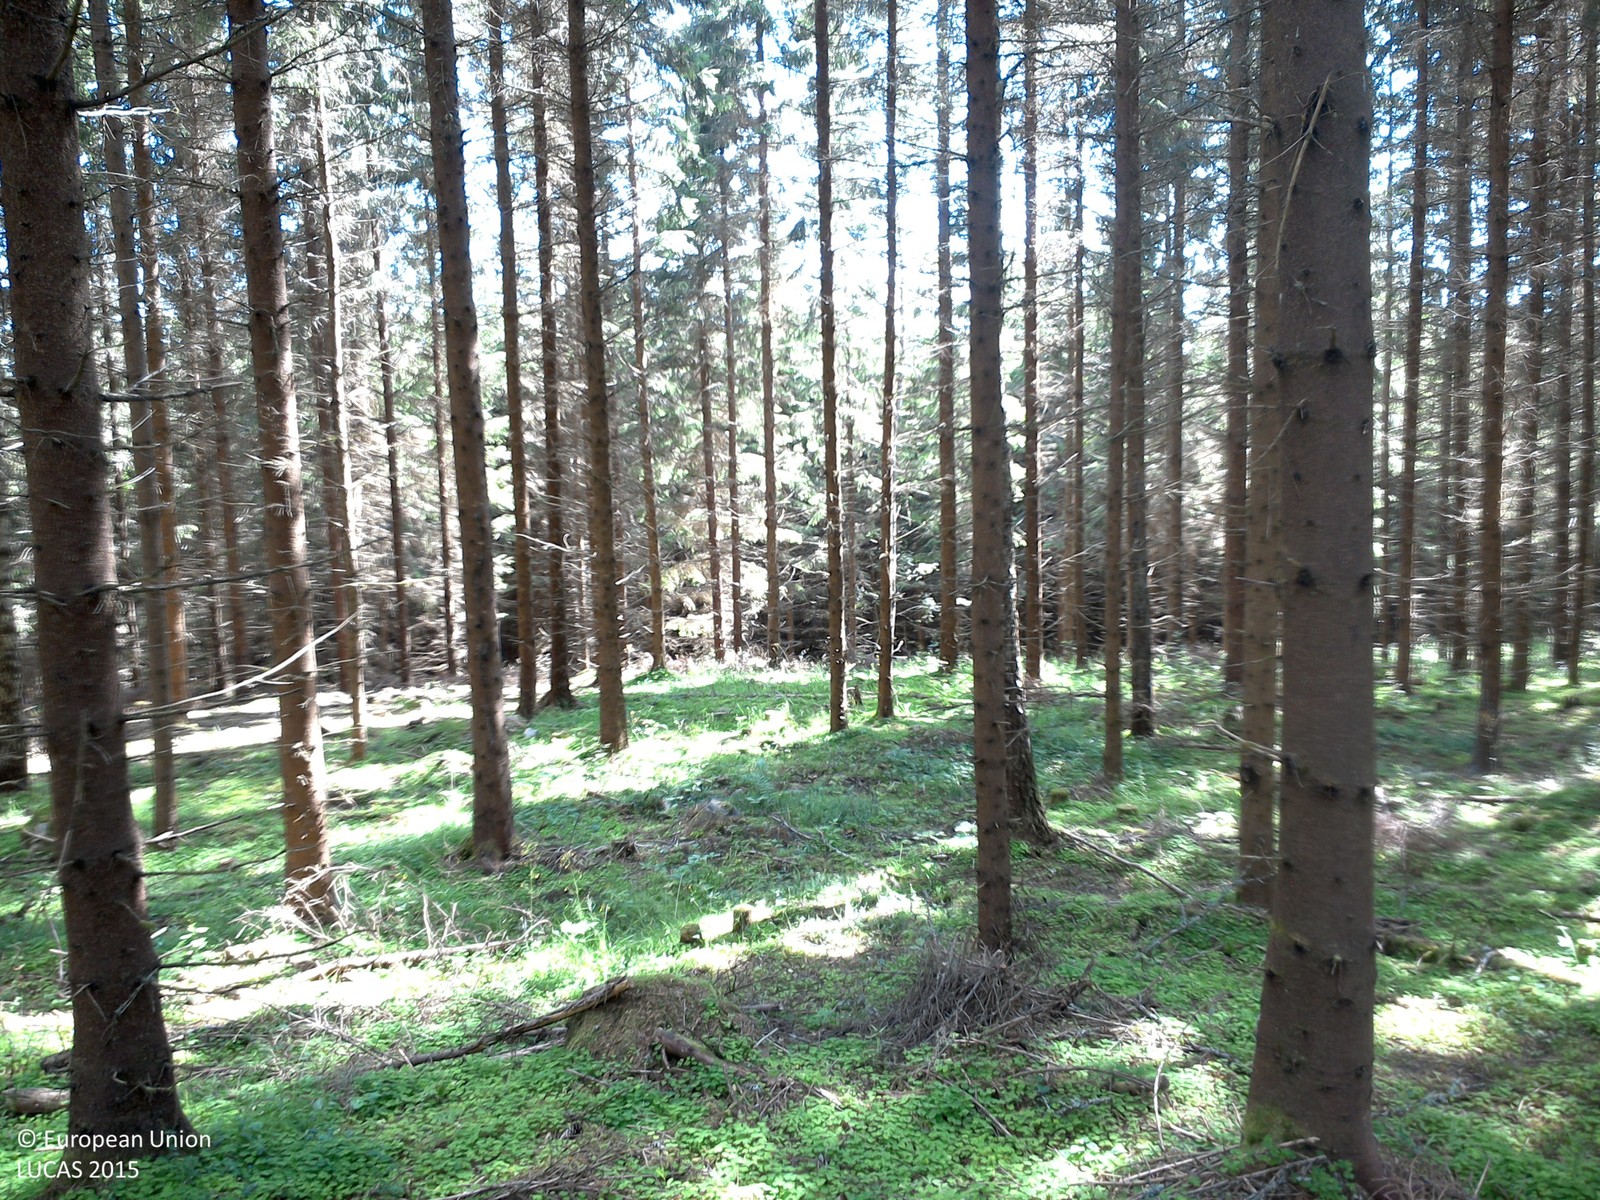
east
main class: Woodland
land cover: Spruce dominated coniferous woodland
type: boreal forest
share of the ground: 50 - 75 %
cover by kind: coniferous forest trees 60 %, herbaceous plants 20 %, lichens and mosses 20 %
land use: Forestry
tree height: > 5 m
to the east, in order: Spruce dominated coniferous woodland; Paved roads, cycling and walking lanes; Spruce dominated coniferous woodland; Ditches and canals; Spruce dominated coniferous woodland; Ditches and canals; Spruce dominated coniferous woodland; Ditches and canals; Spruce dominated coniferous woodland
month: July
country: SE
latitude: 58.0095
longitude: 14.7503
